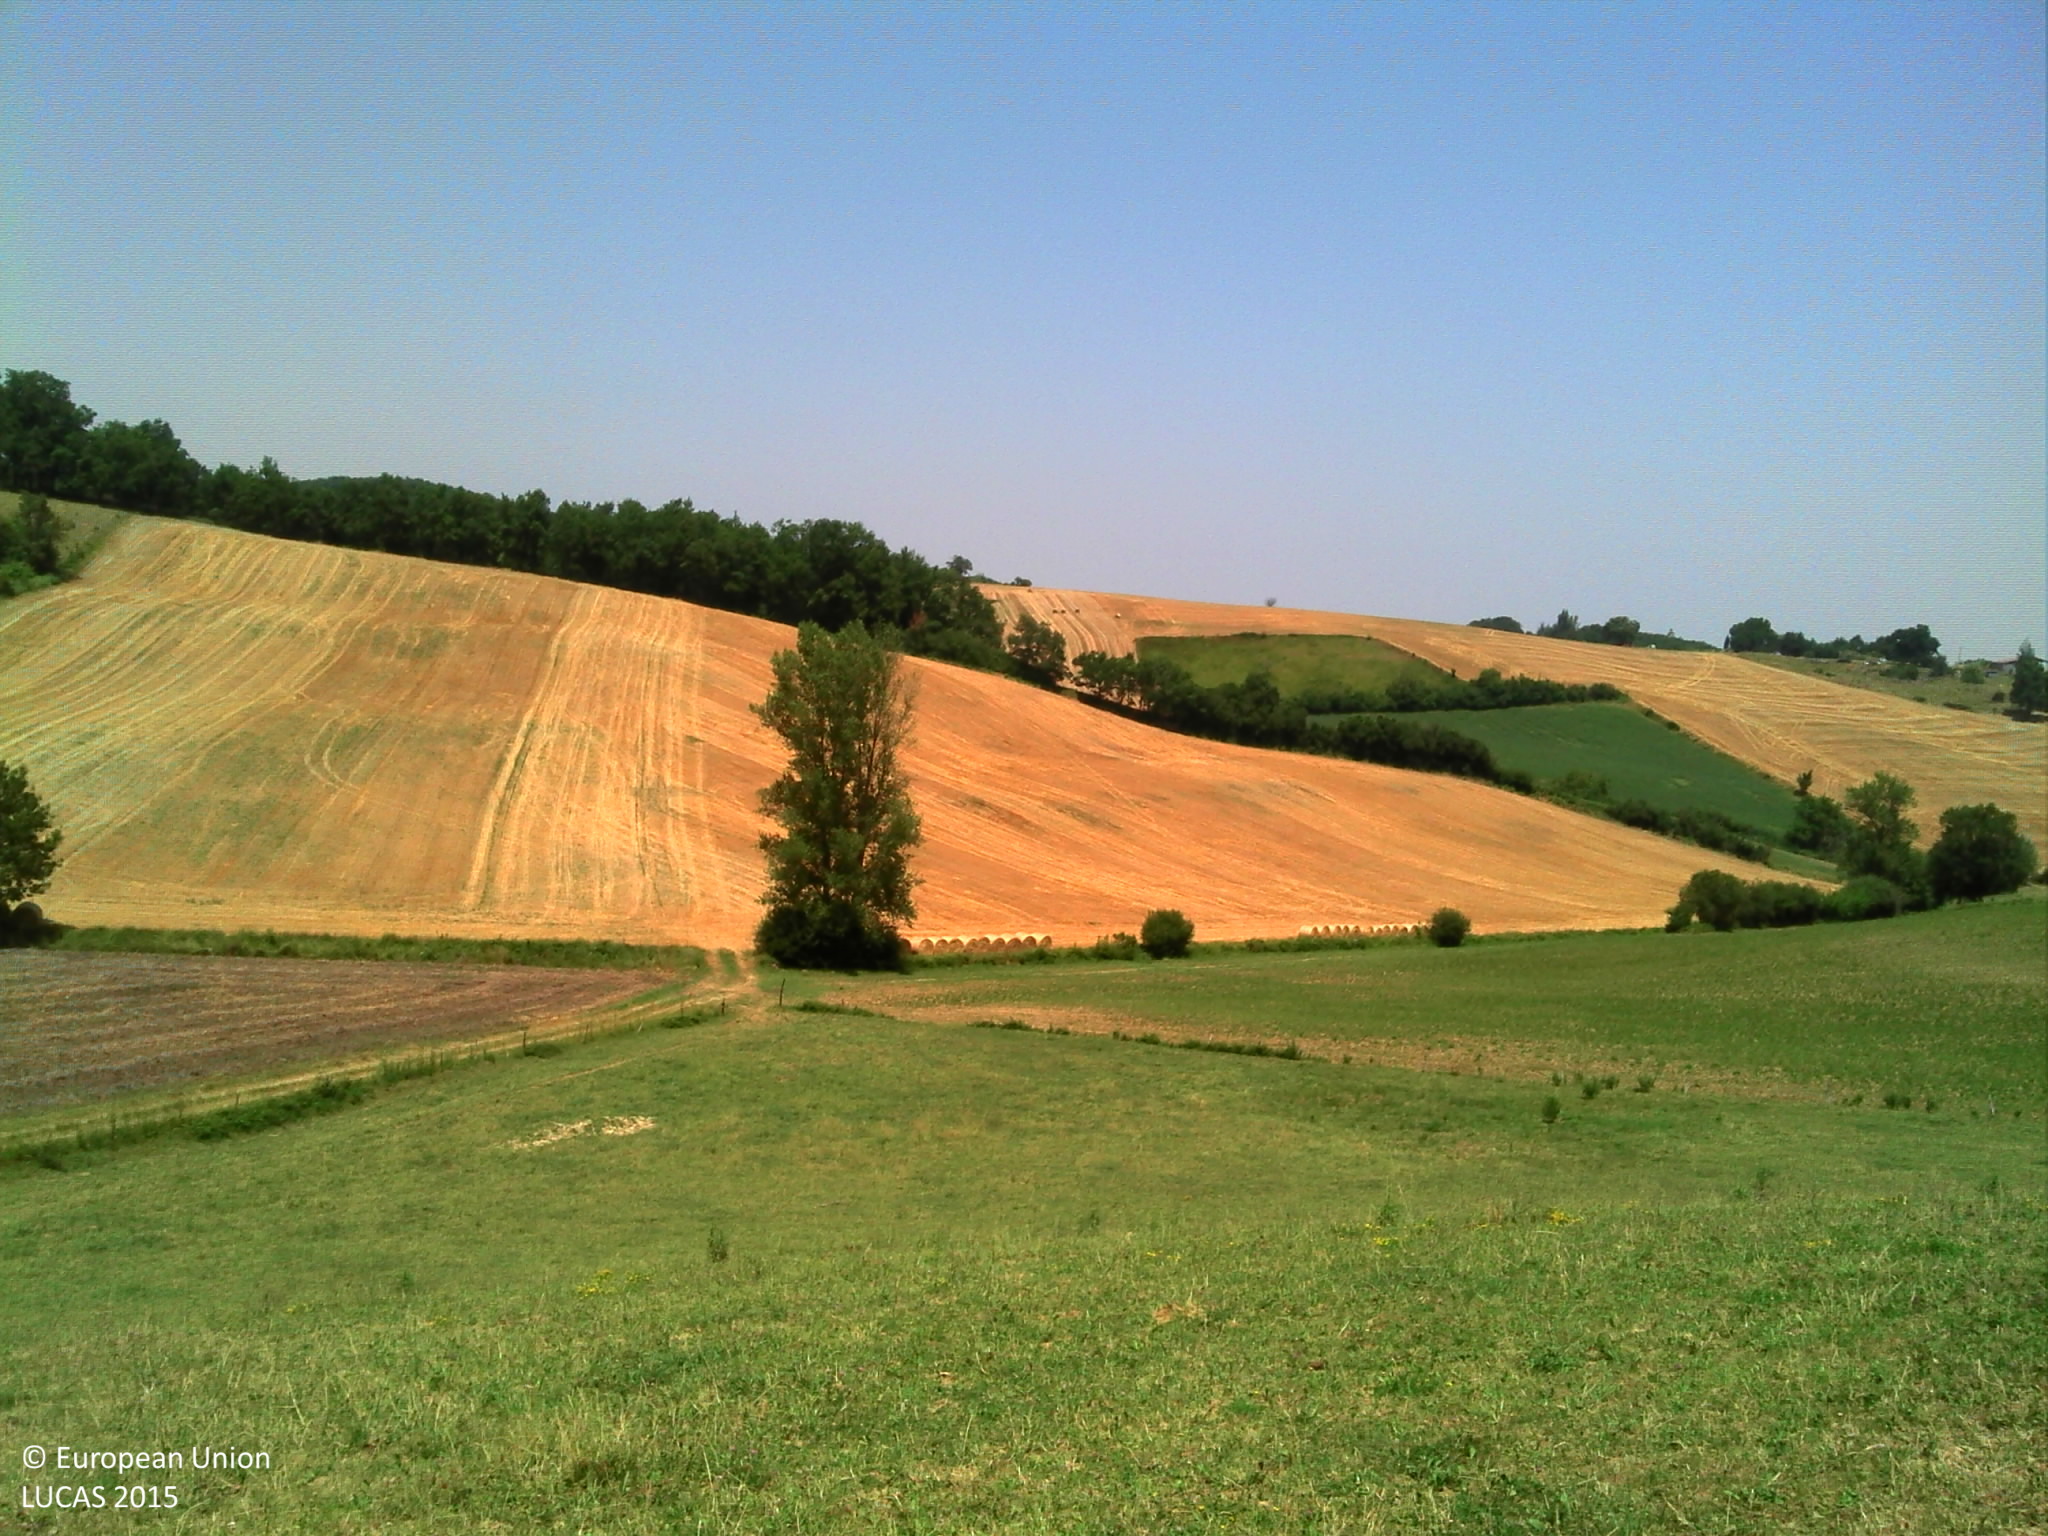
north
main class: Grassland
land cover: Grassland without tree/shrub cover
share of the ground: > 75 %
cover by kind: herbaceous plants 100 %
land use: Agriculture (excluding fallow land and kitchen gardens)
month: July
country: FR
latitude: 43.1236
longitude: 1.4135
